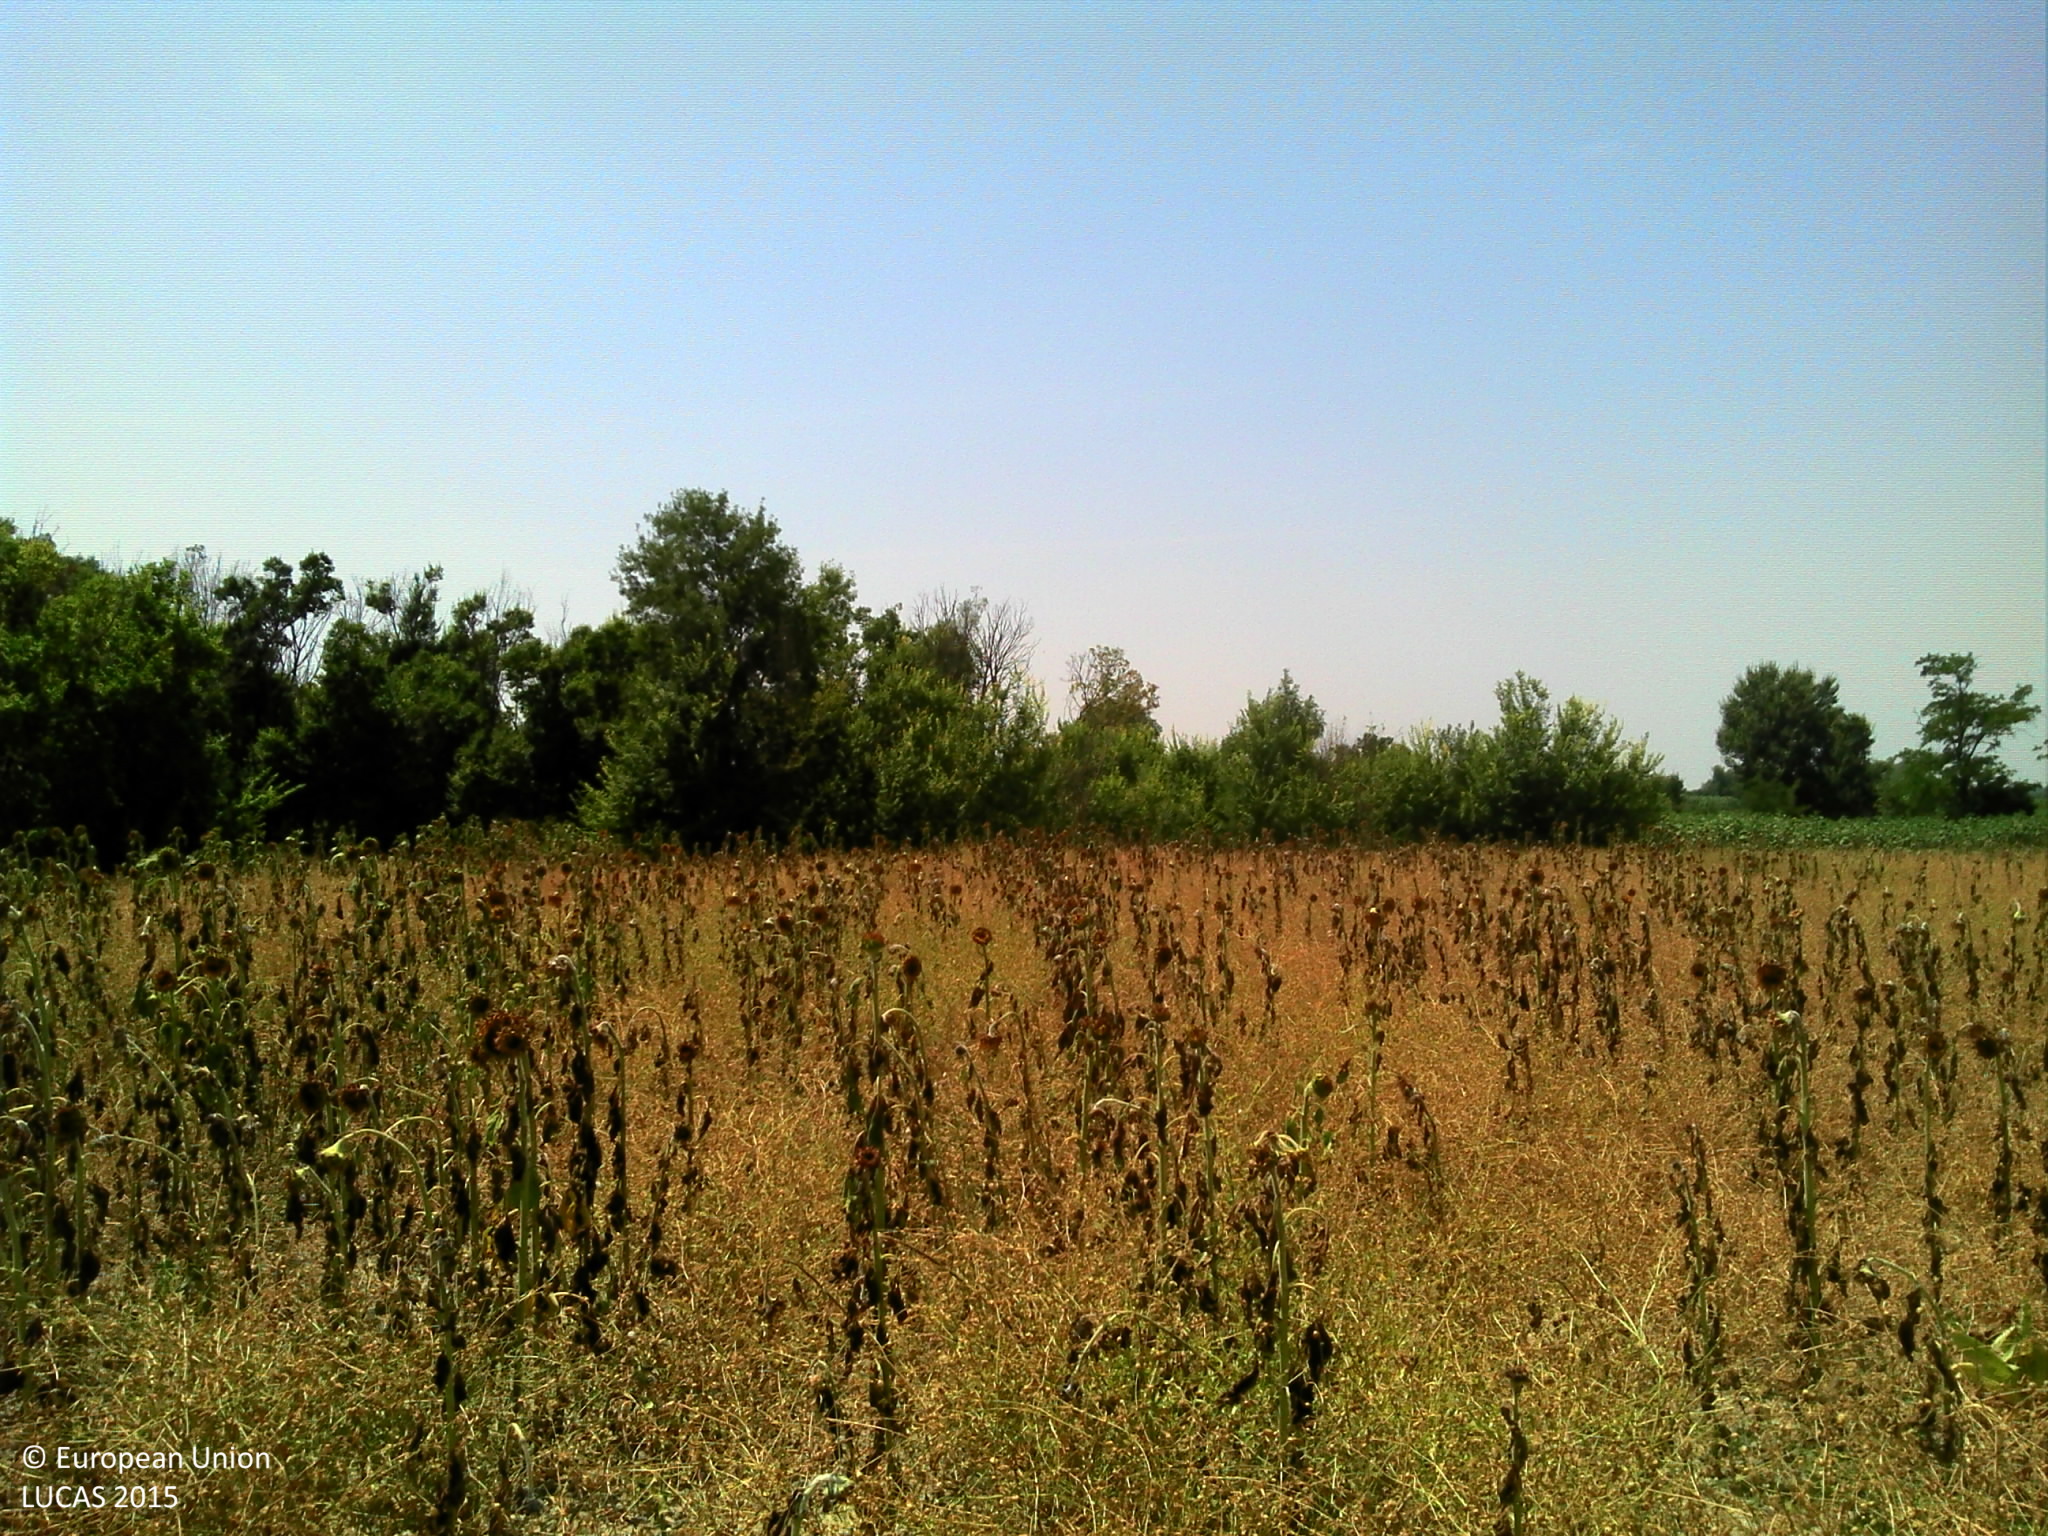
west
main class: Cropland
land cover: Sunflower
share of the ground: 25 - 50 %
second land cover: Spontaneously vegetated surfaces
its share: 25 - 50 %
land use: Agriculture (excluding fallow land and kitchen gardens)
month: July
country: FR
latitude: 43.7070
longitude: 4.6606
